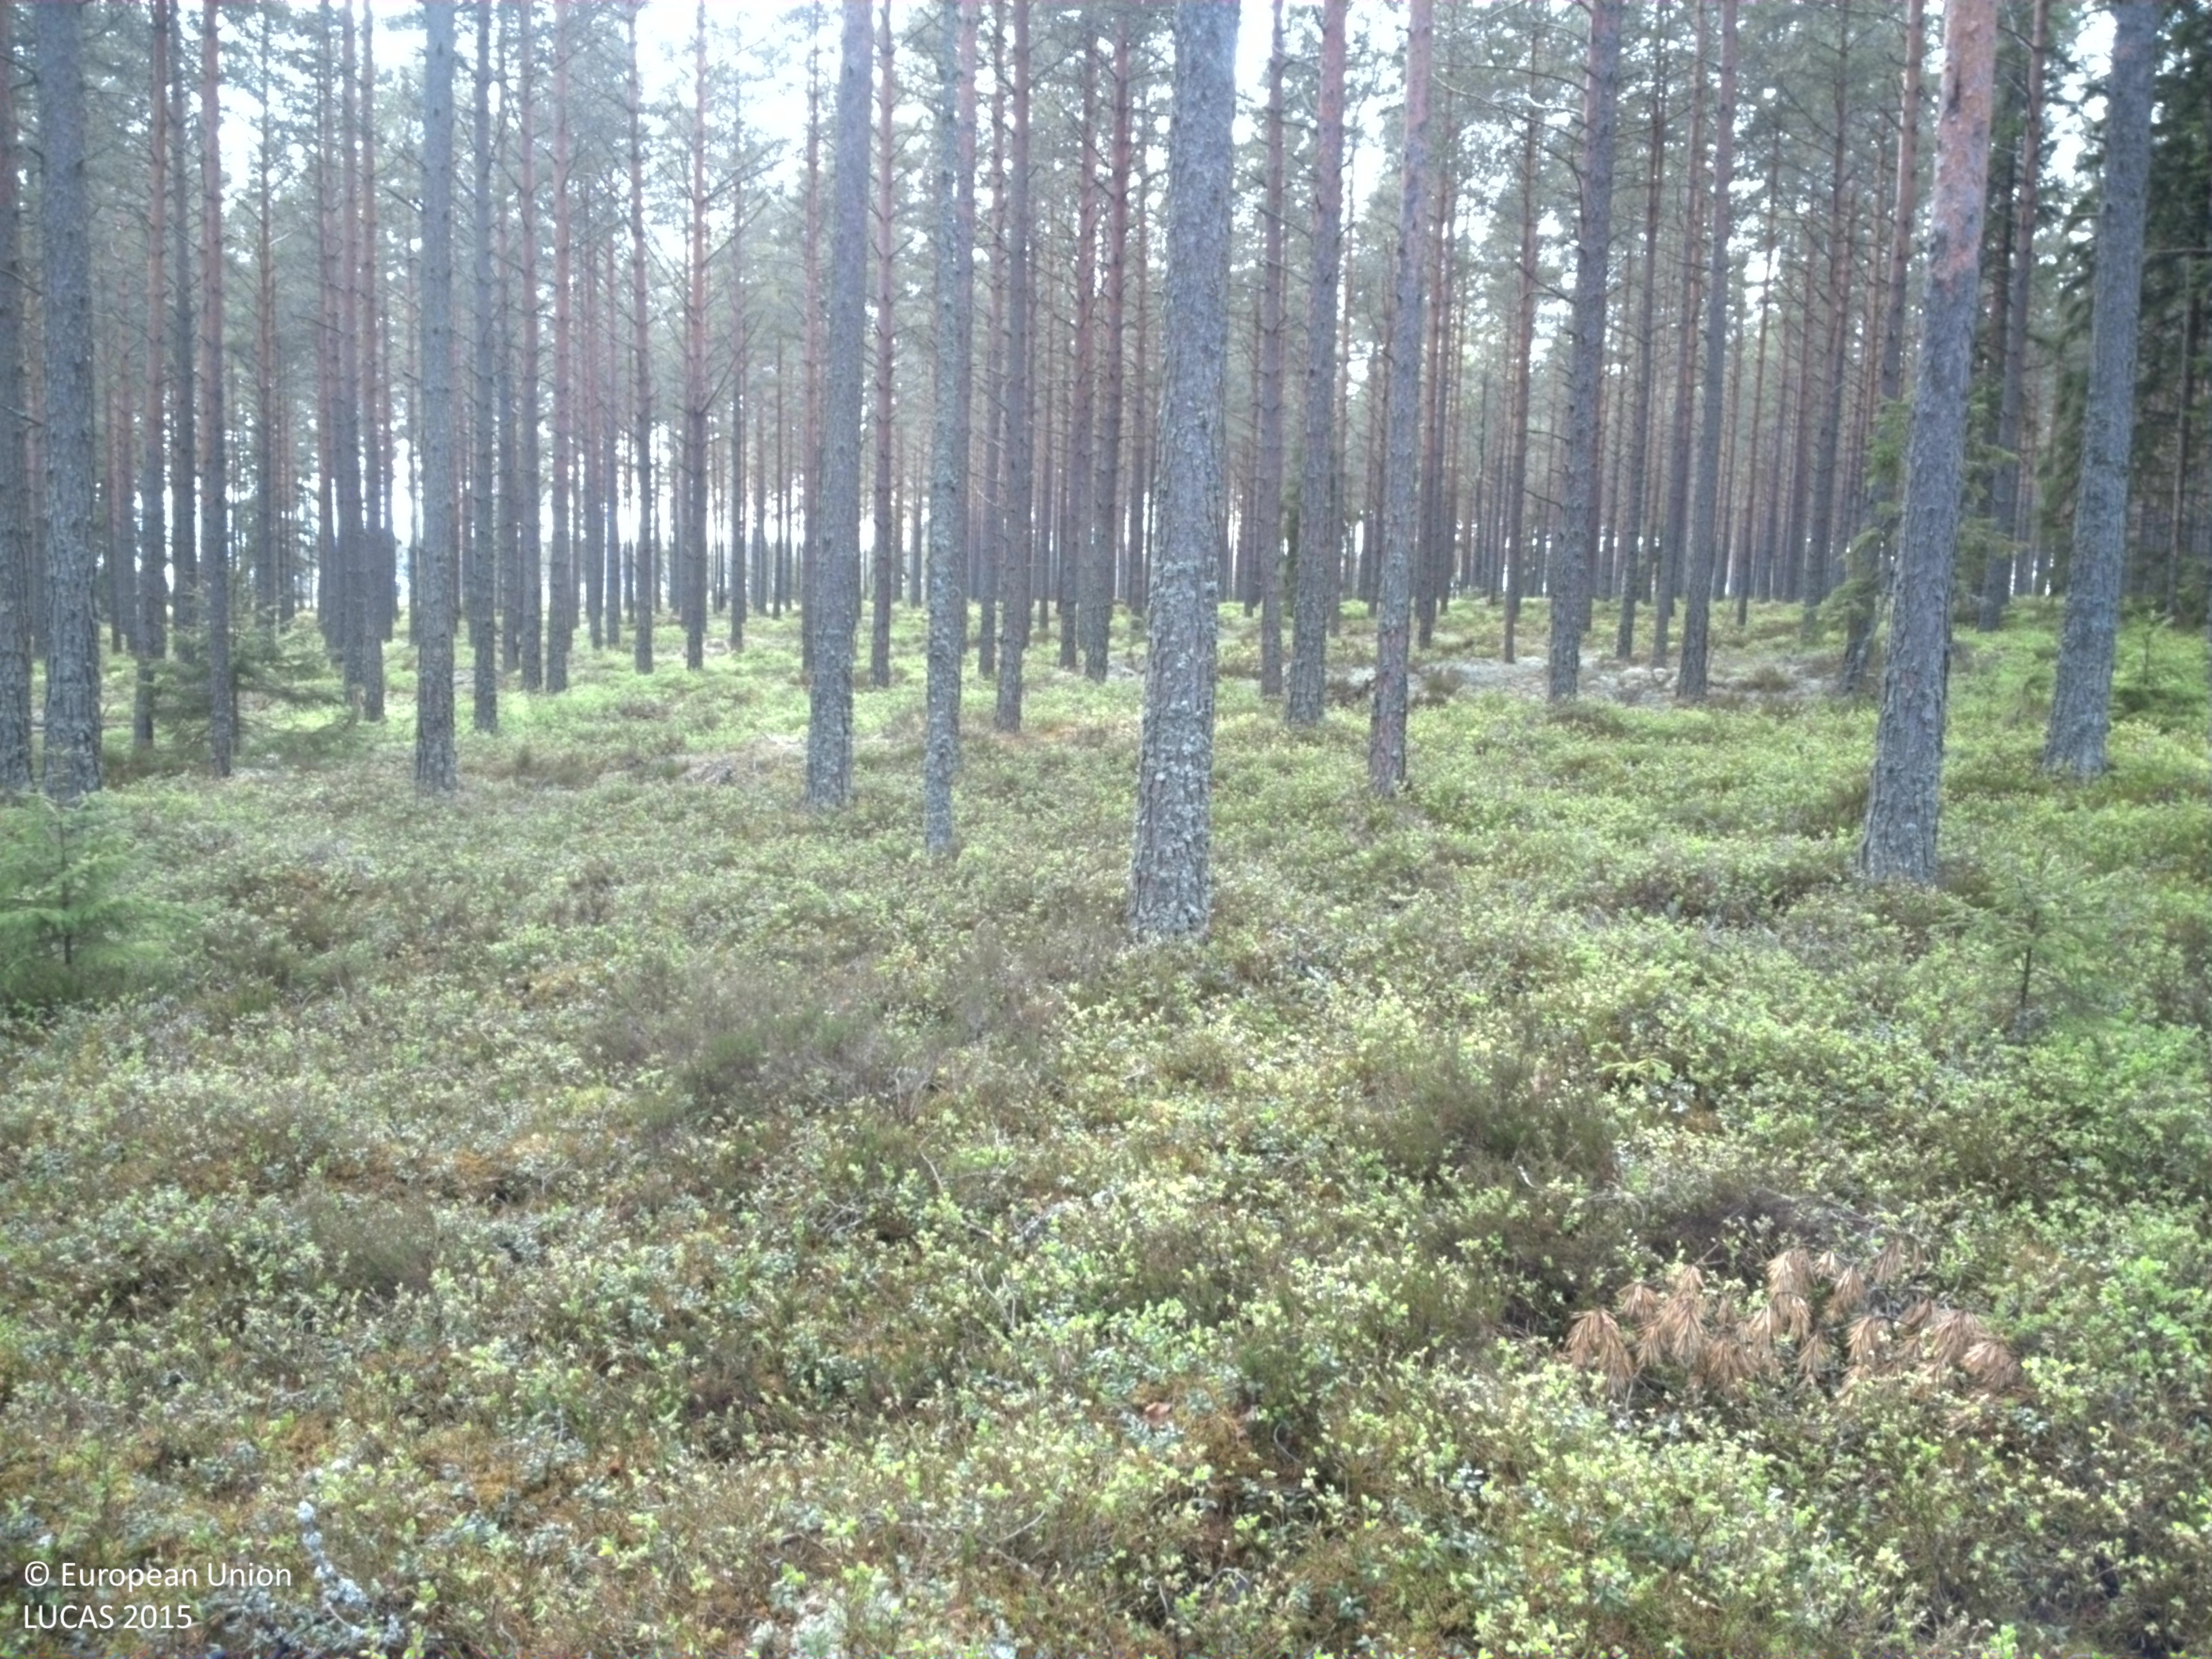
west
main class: Woodland
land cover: Pine dominated coniferous woodland
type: boreal forest
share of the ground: 50 - 75 %
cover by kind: coniferous forest trees 50 %, shrubs 40 %, herbaceous plants 5 %, lichens and mosses 5 %
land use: Forestry
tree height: > 5 m
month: May
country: SE
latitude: 59.1583
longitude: 14.3464
